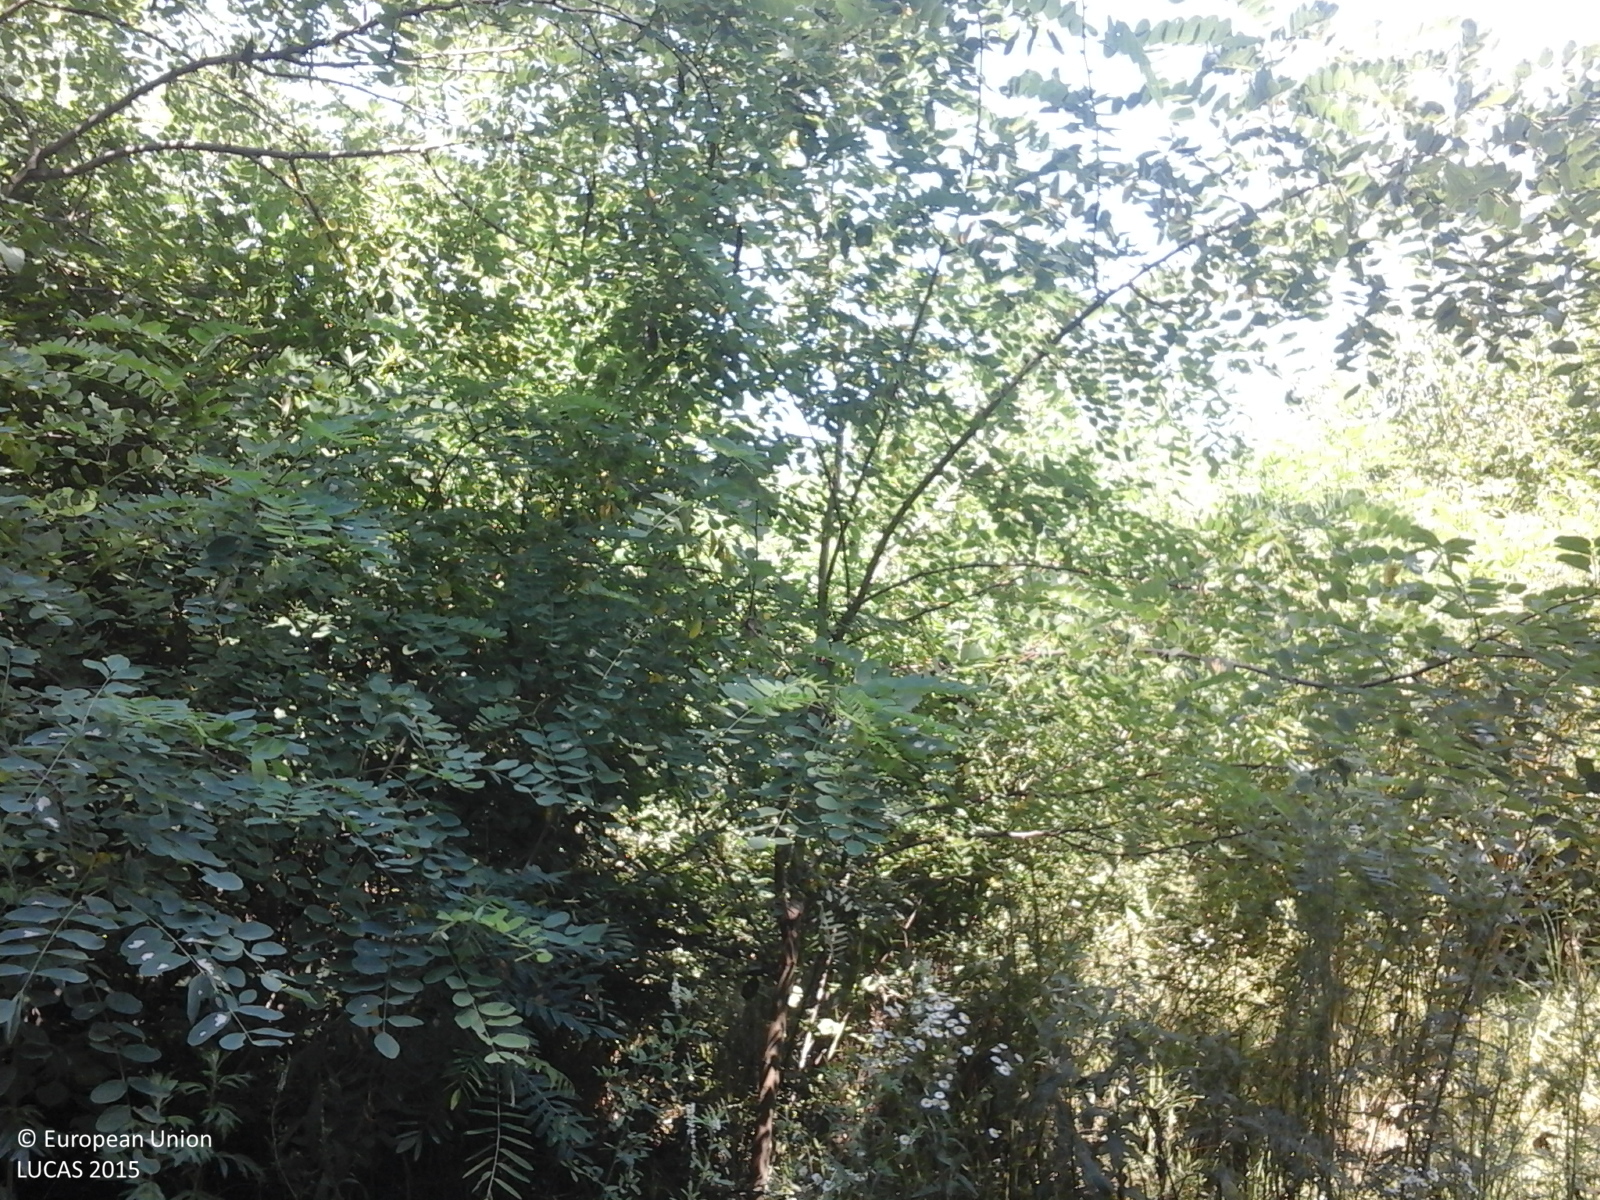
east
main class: Woodland
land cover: Broadleaved woodland
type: beech forest
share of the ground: > 75 %
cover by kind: broadleaved forest trees 100 %
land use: Forestry
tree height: > 5 m
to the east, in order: Broadleaved woodland; Tracks; Broadleaved woodland; Tracks; Electric lines; Abandoned hedges; Inland fresh running water; Grass margins; Tracks; Grassland without tree/shrub cover; Tracks; Inland fresh running water
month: July
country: RO
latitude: 44.4511
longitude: 24.3048
